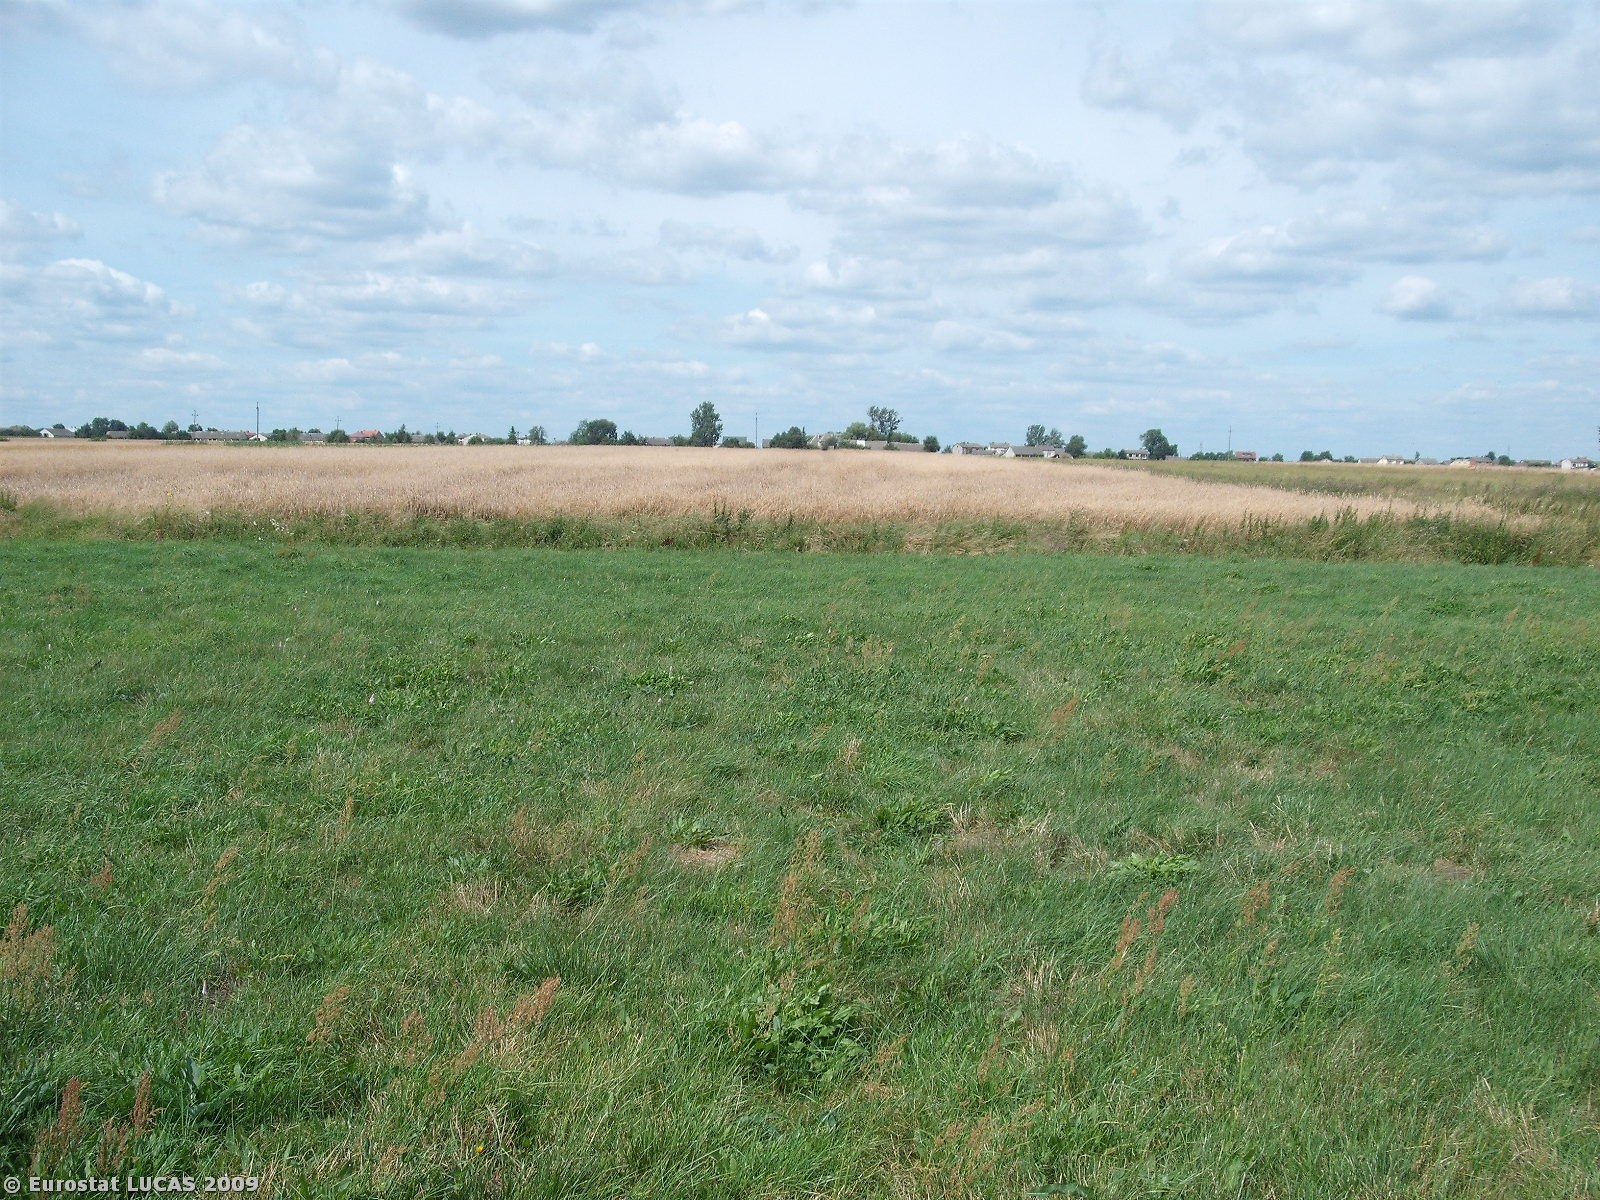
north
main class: Grassland
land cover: Grassland without tree/shrub cover
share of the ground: > 75 %
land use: Agriculture (excluding fallow land and kitchen gardens)
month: July
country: PL
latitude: 51.3271
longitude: 21.4888
